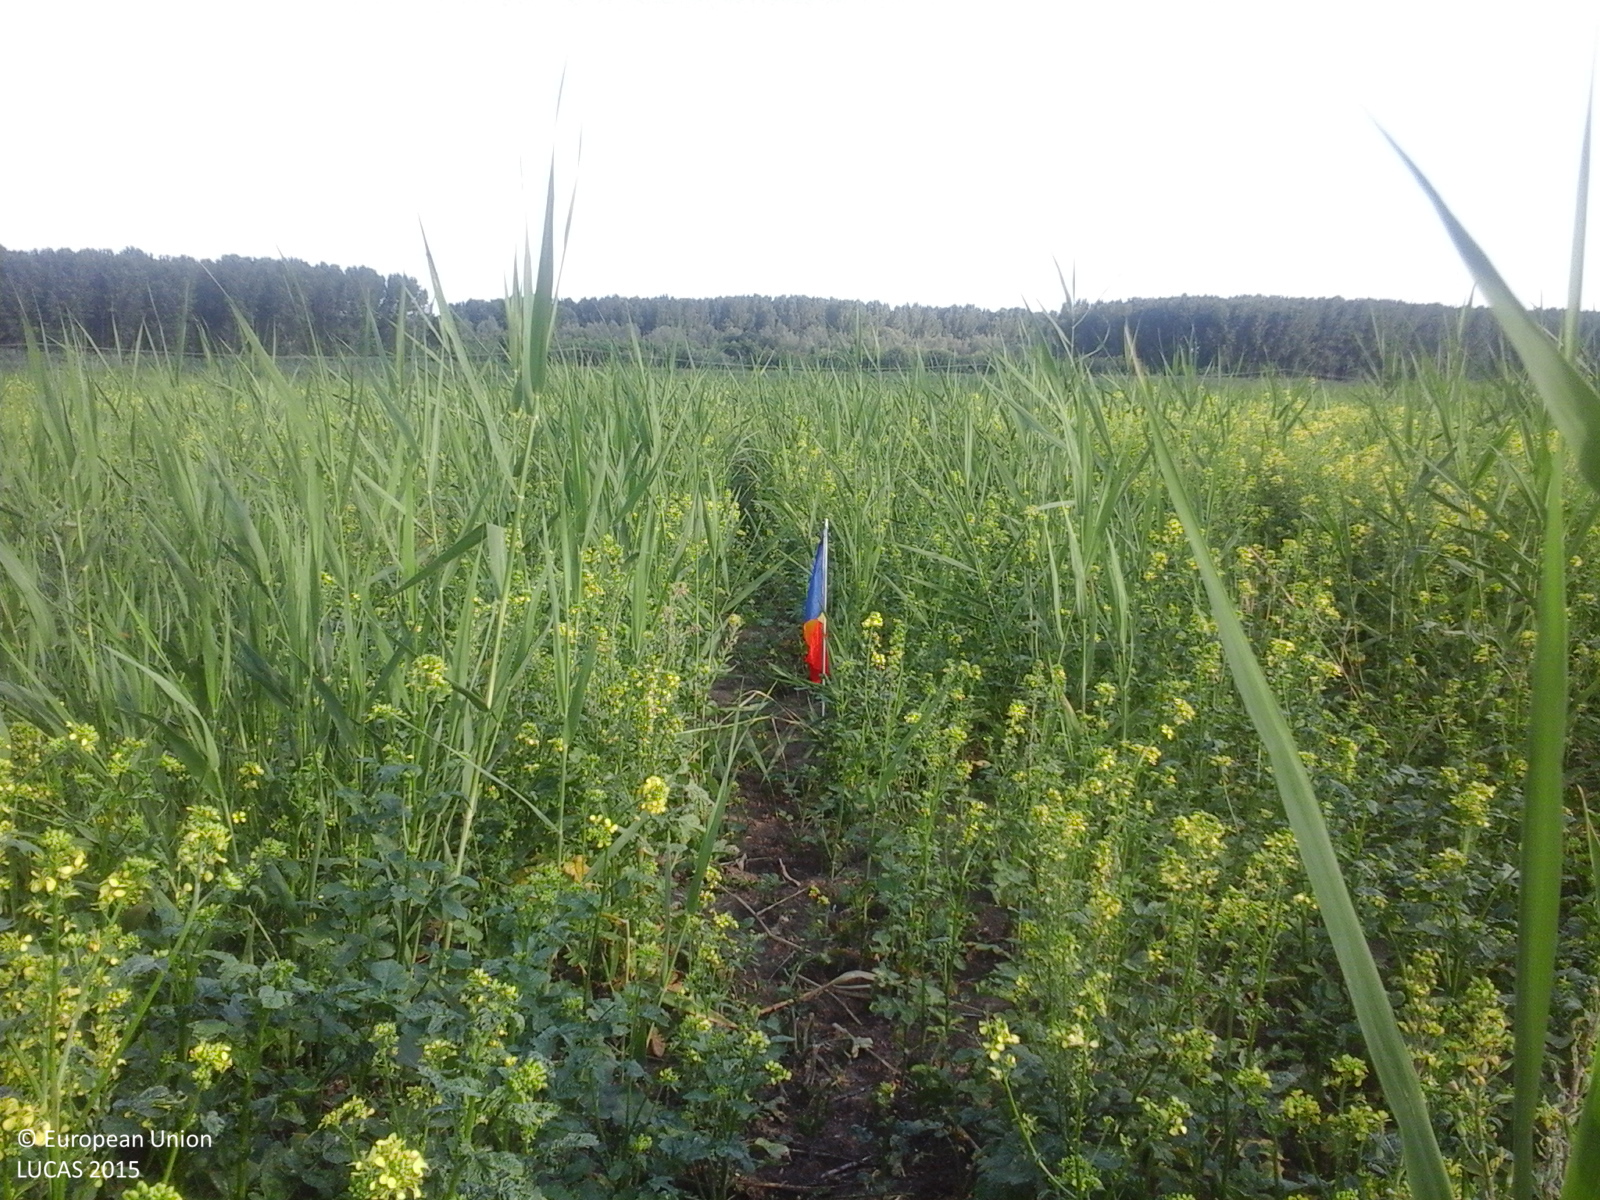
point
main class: Cropland
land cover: Other fibre and oleaginous crops
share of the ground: > 75 %
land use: Agriculture (excluding fallow land and kitchen gardens)
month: July
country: RO
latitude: 43.7546
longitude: 25.8020
